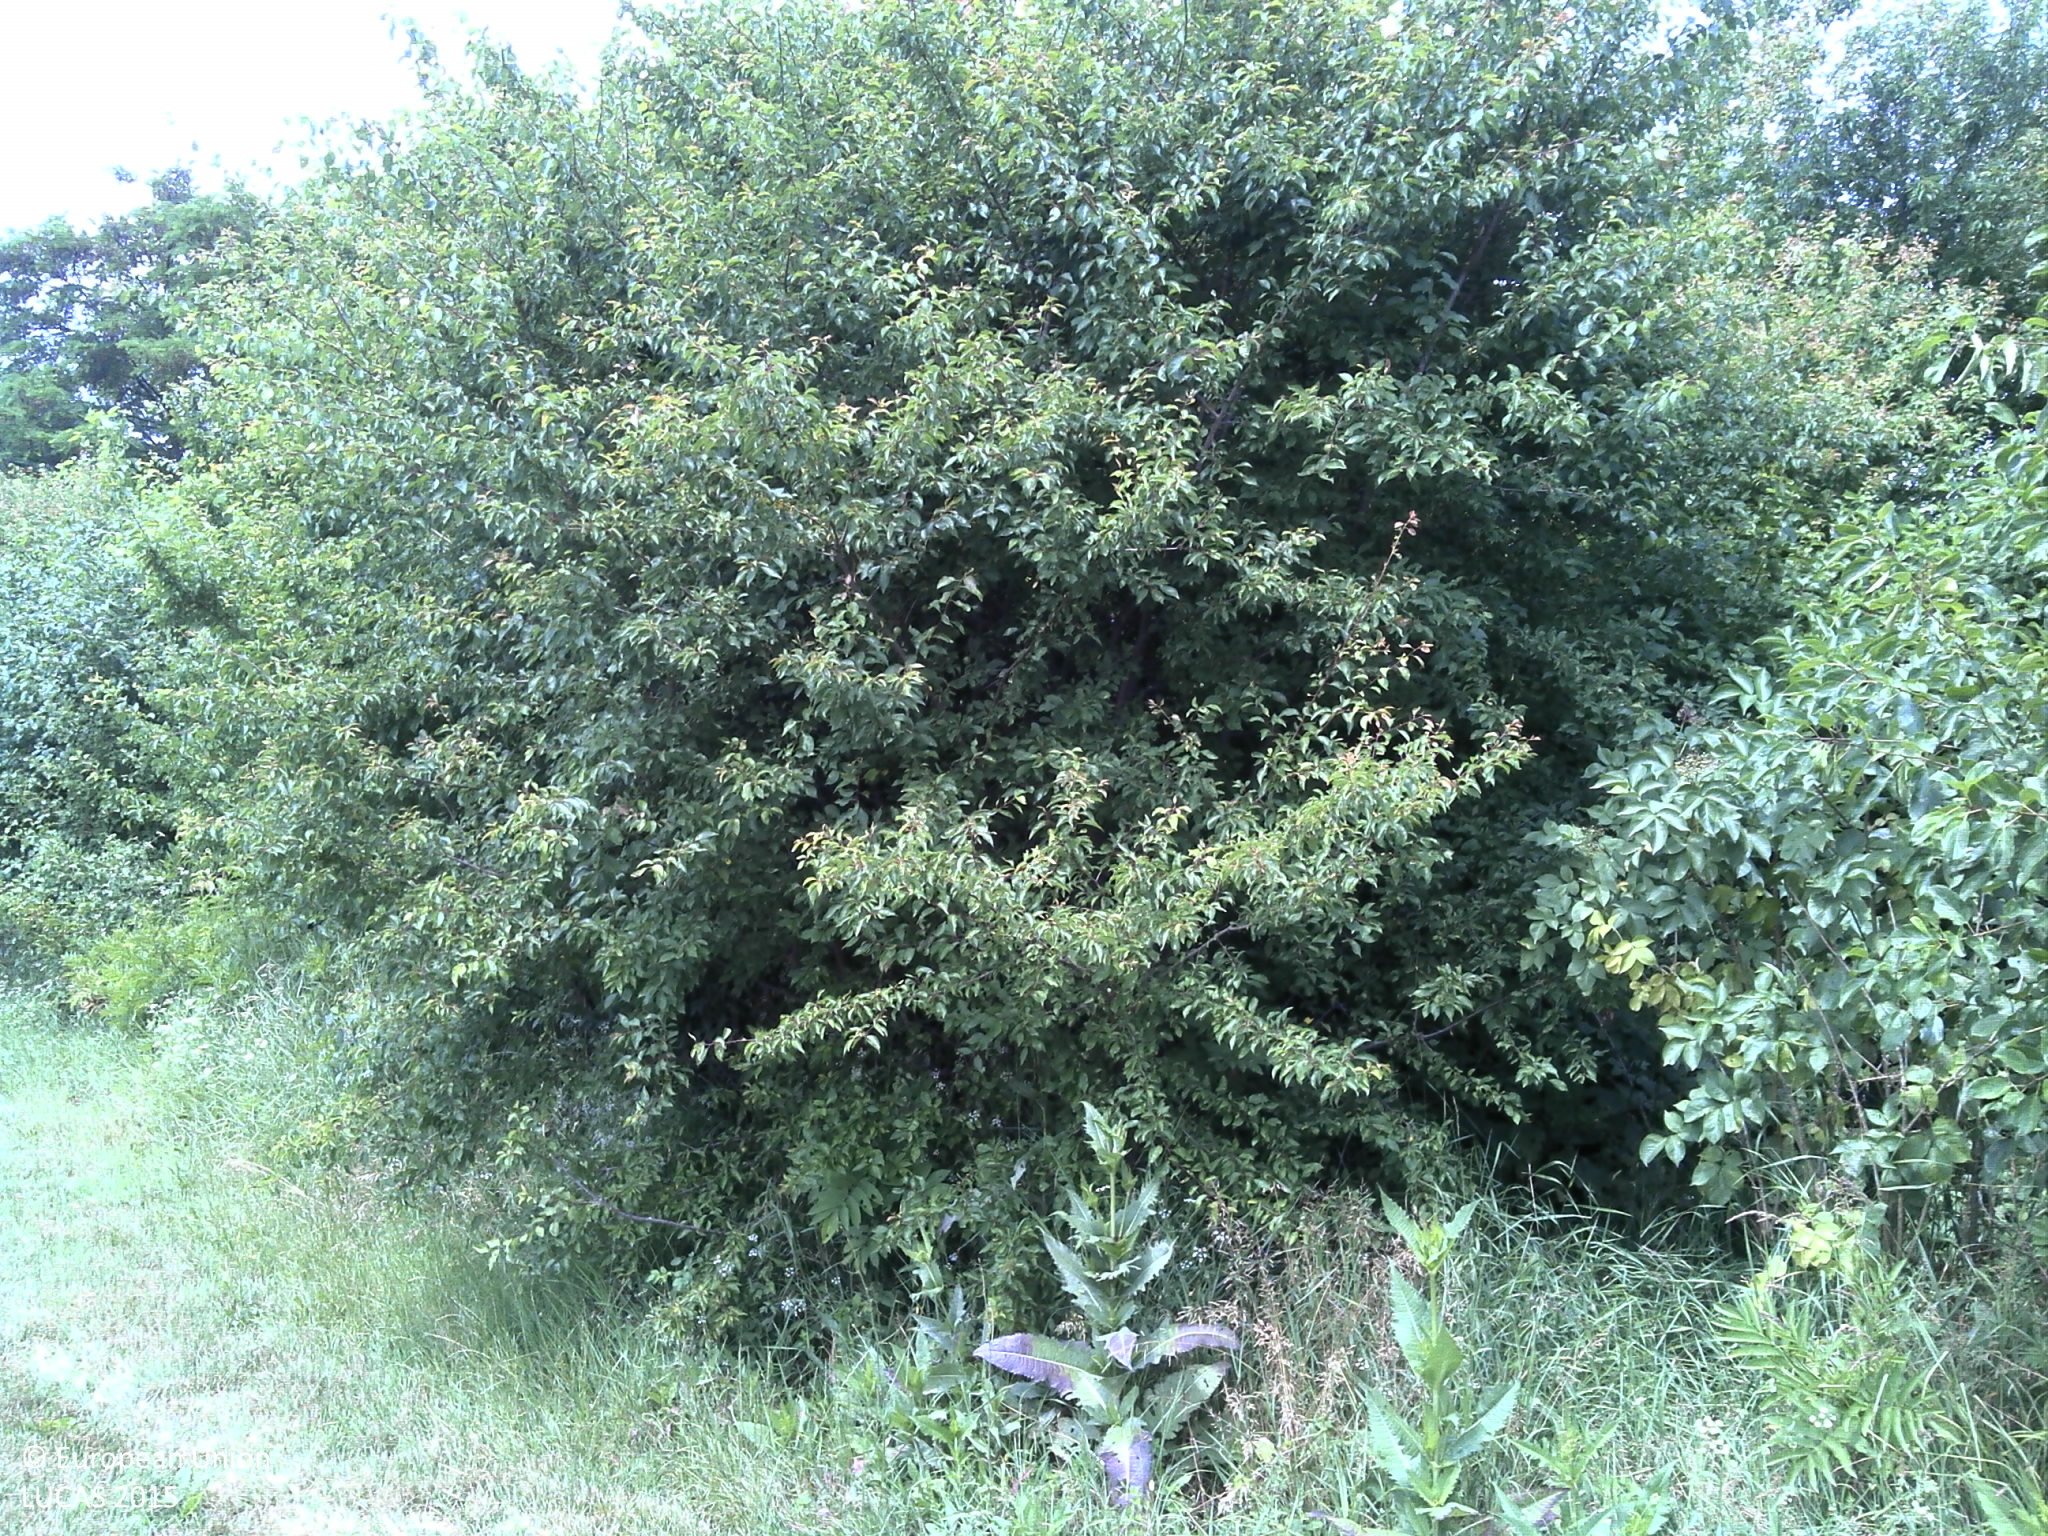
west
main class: Grassland
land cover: Grassland without tree/shrub cover
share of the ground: > 75 %
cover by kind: herbaceous plants 100 %
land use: Agriculture (excluding fallow land and kitchen gardens)
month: June
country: HR
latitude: 45.5080
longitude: 18.4667
